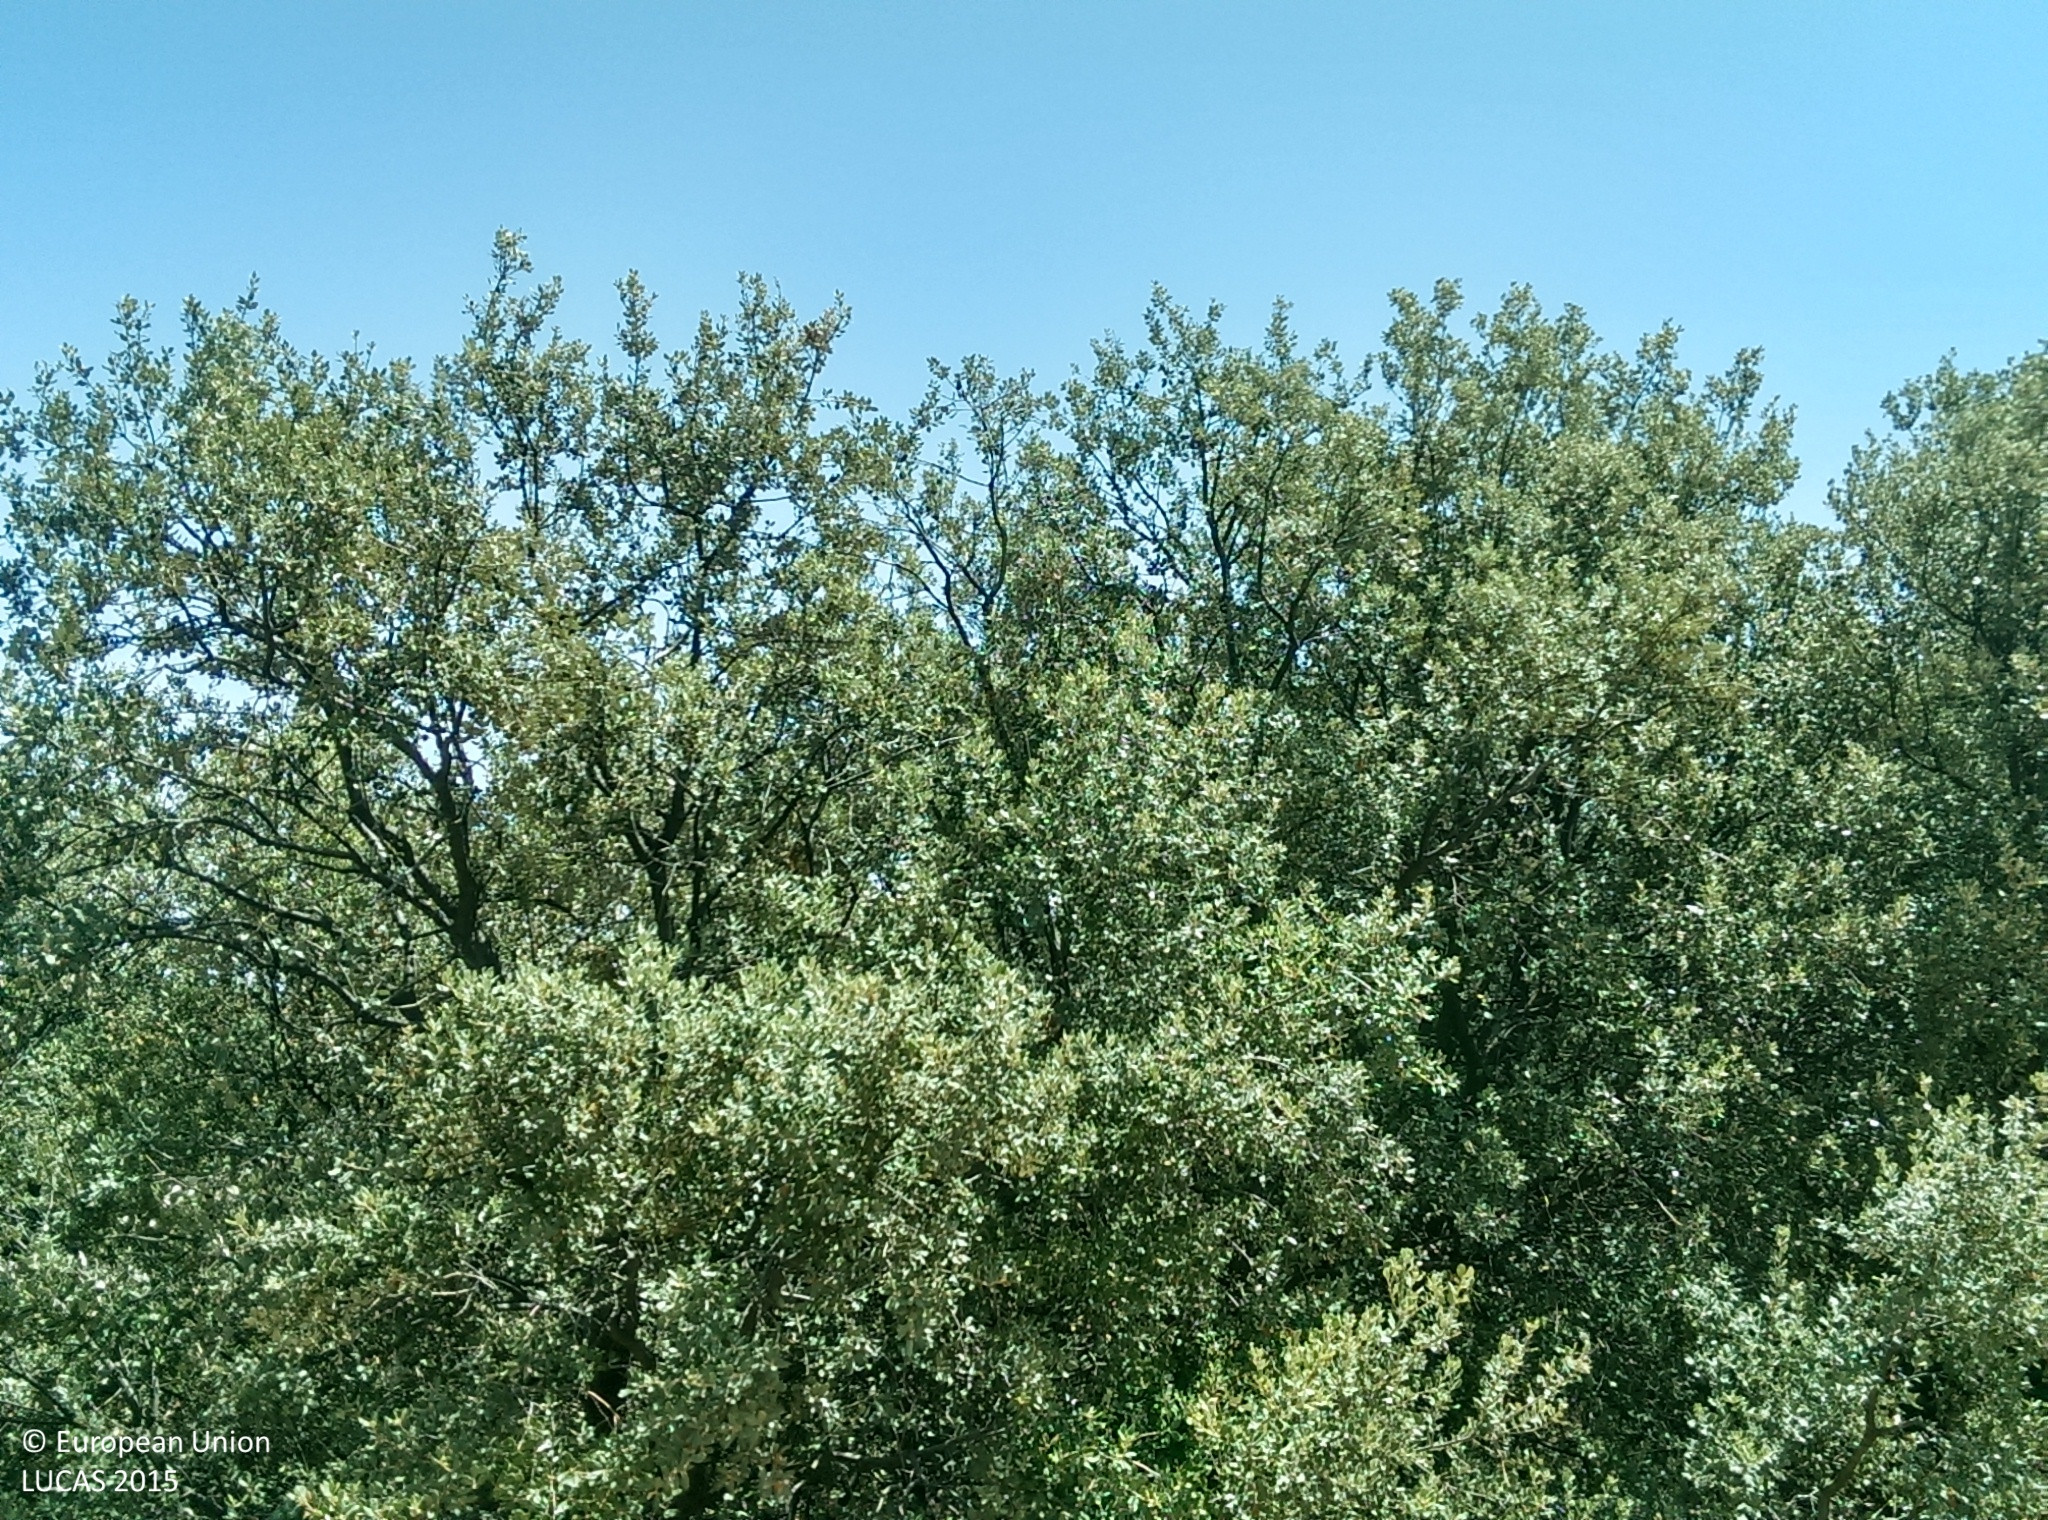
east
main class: Cropland
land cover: Oats
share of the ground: < 10 %
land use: Agriculture (excluding fallow land and kitchen gardens)
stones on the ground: 25 - 50 %
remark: Harvested field
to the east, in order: Oats; Broadleaved woodland; Rivers and streams; Broadleaved woodland; Olive groves; Tracks; Olive groves; Grass margins; Barley; Ditches and canals; Tracks; Broadleaved woodland
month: July
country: ES
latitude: 37.2374
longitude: -3.2544
